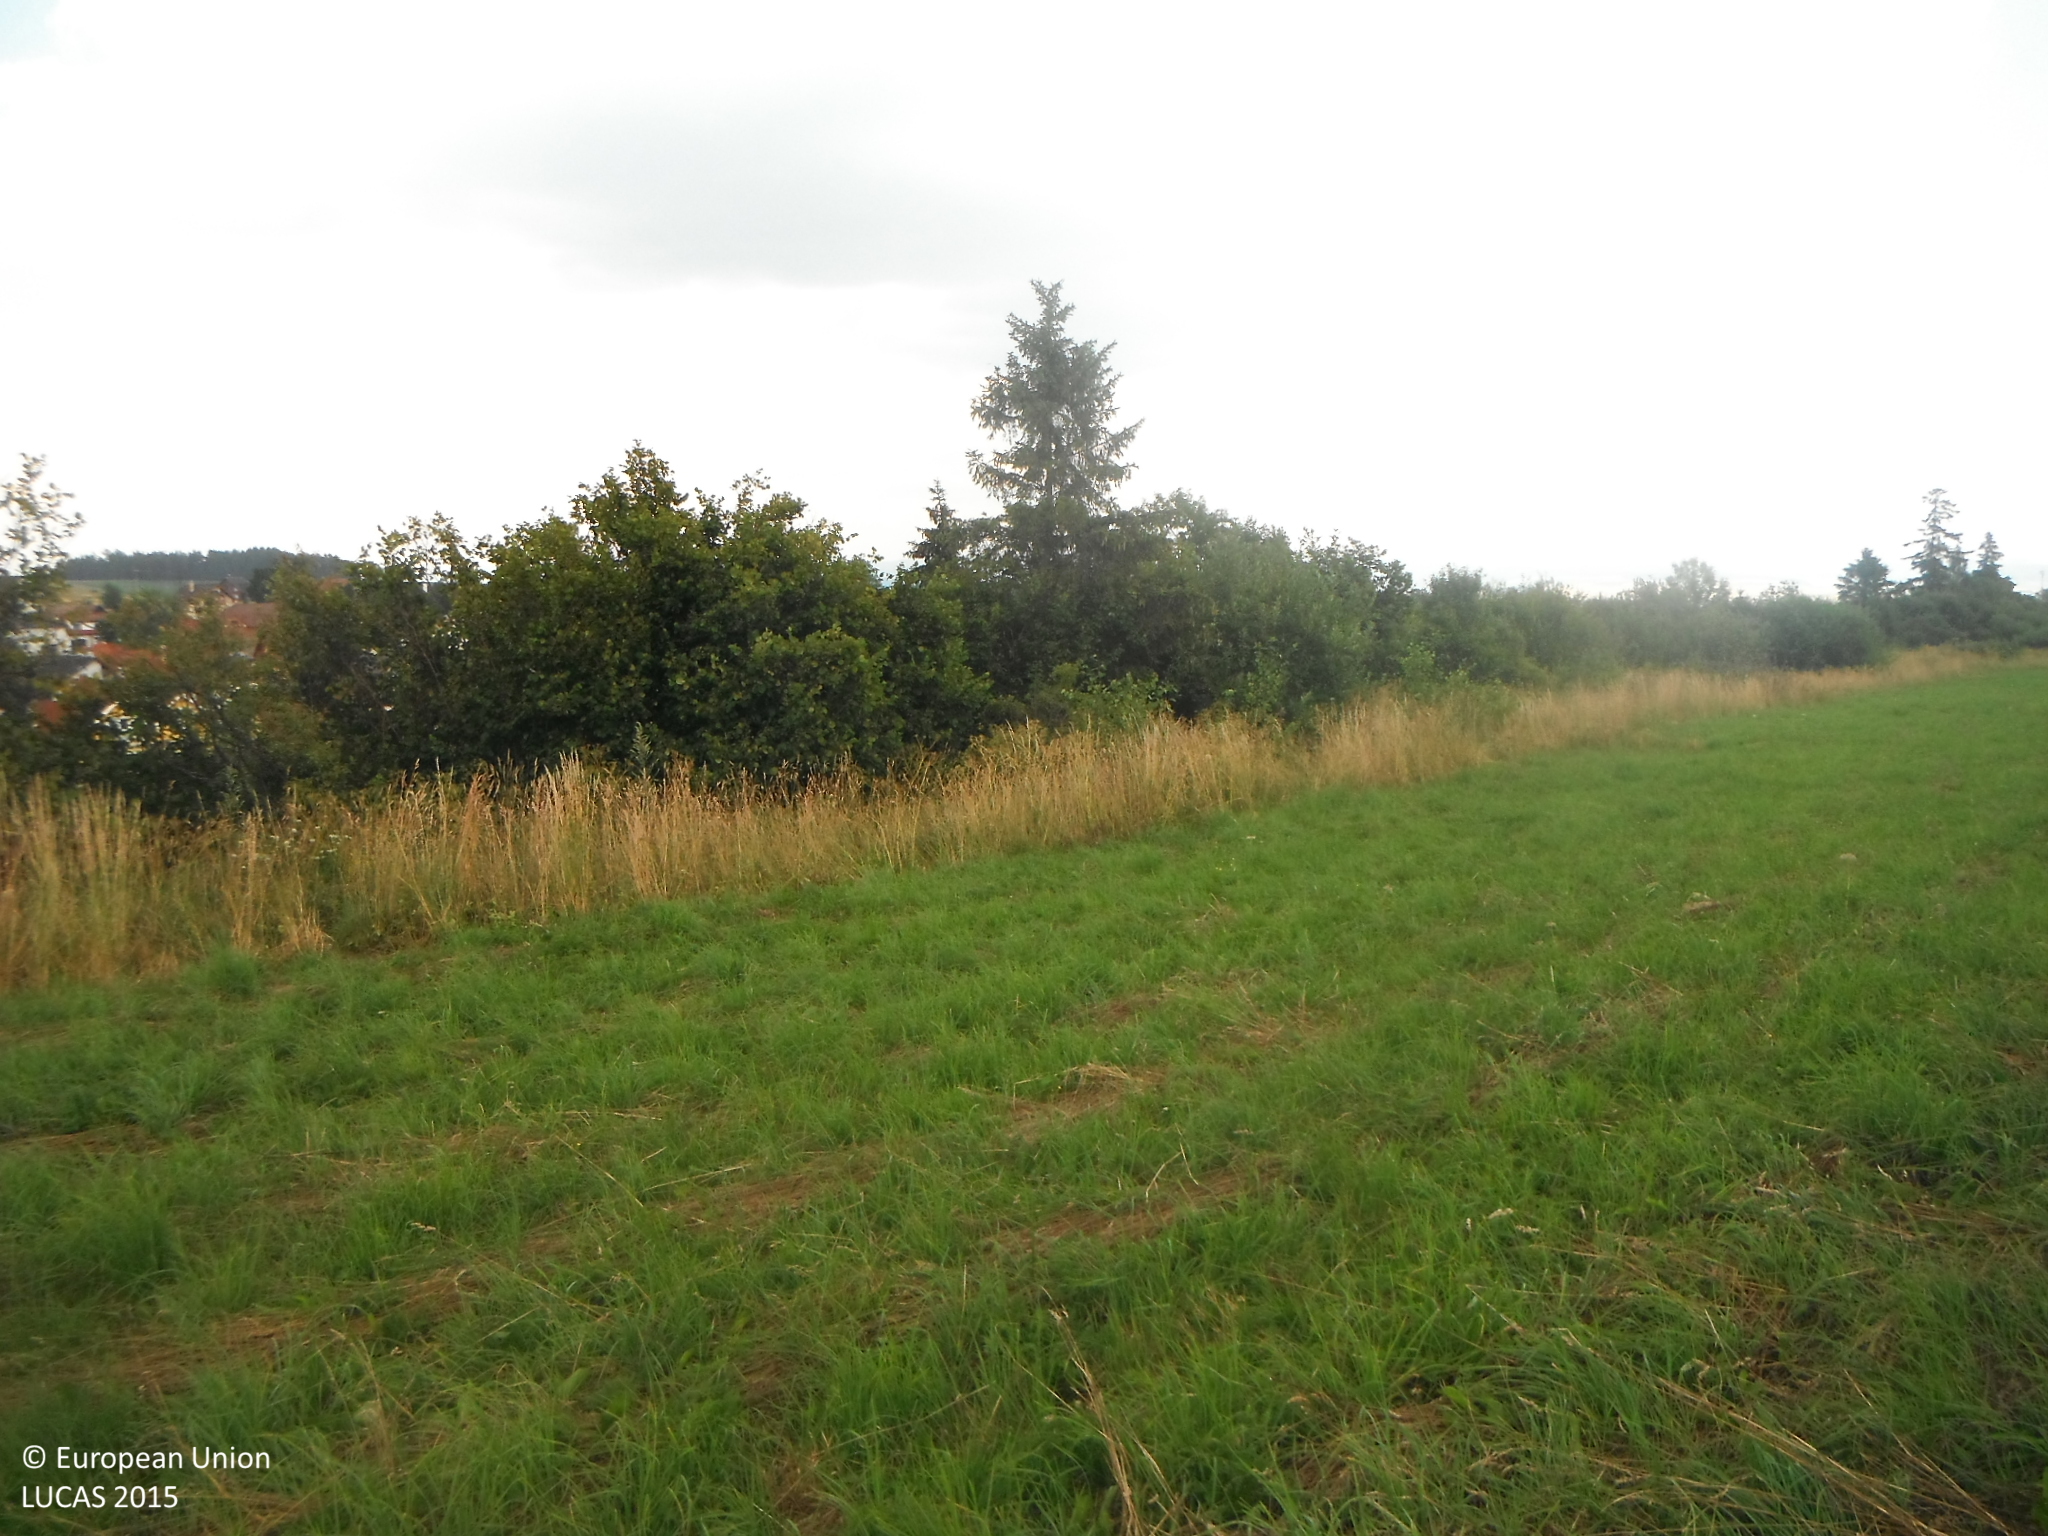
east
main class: Grassland
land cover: Grassland without tree/shrub cover
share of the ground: > 75 %
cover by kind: herbaceous plants 100 %
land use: Agriculture (excluding fallow land and kitchen gardens)
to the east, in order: Grassland without tree/shrub cover; Shrubland with sparse tree cover; Inland fresh running water; Shrubland with sparse tree cover; Grassland without tree/shrub cover; Artificial constructions in urban areas; Grassland with sparse tree/shrub cover; Tracks; Grassland with sparse tree/shrub cover; Grassland without tree/shrub cover
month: July
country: SK
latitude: 49.1362
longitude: 20.3002
